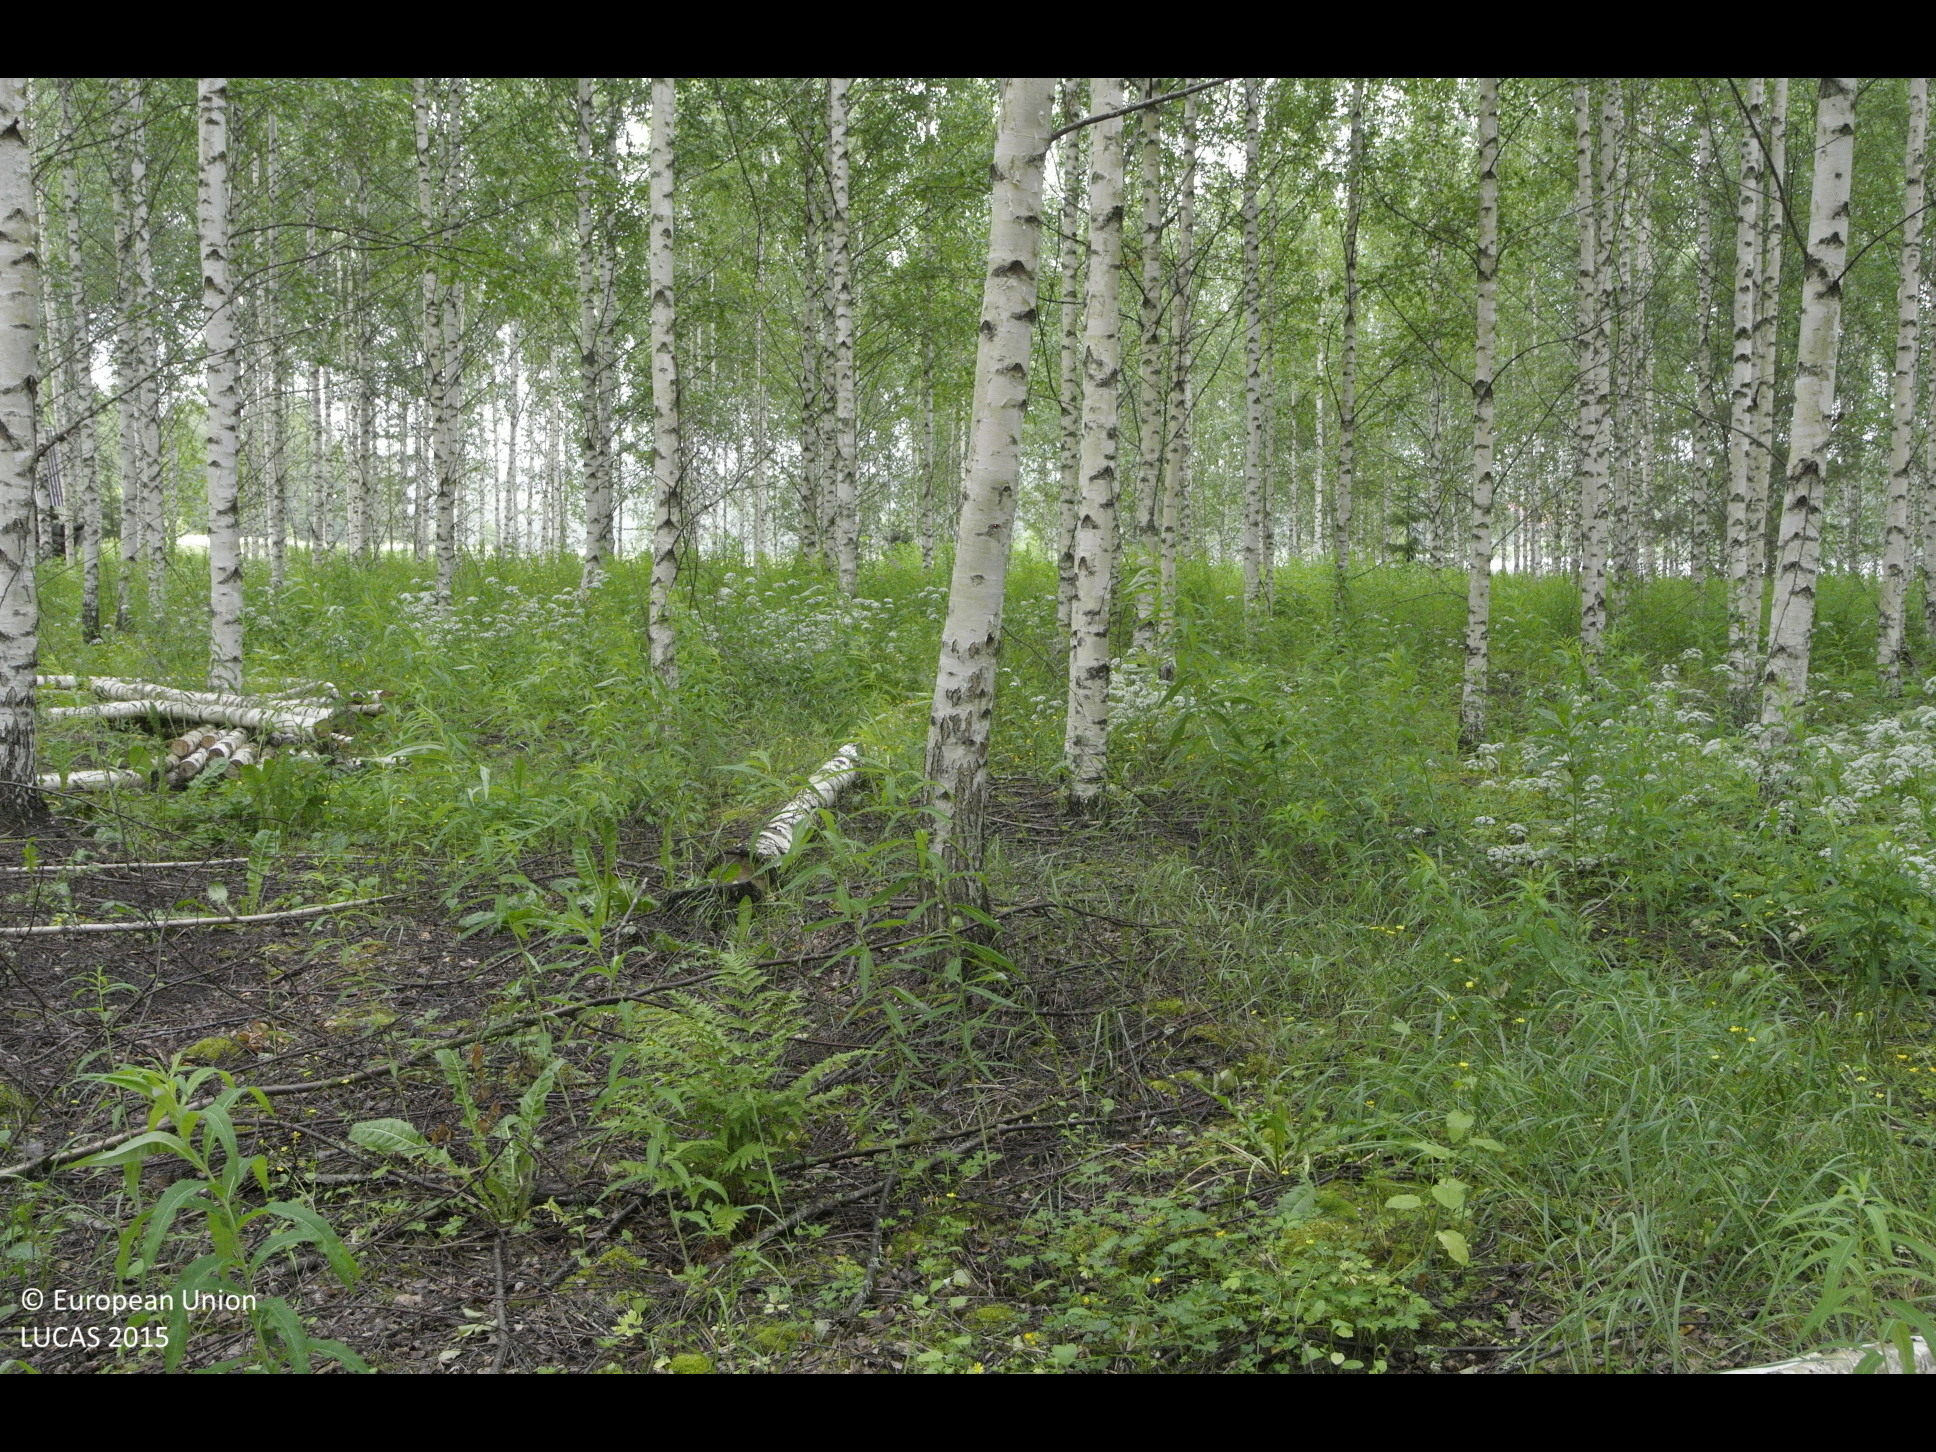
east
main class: Woodland
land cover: Broadleaved woodland
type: non-riverine alder, birch or aspen forest
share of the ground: > 75 %
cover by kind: broadleaved forest trees 85 %, herbaceous plants 15 %
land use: Forestry
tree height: > 5 m
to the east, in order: Broadleaved woodland; Ditches and canals; Grassland without tree/shrub cover; Inland marshes; Inland fresh water bodies
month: July
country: FI
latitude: 61.5483
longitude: 25.8019
